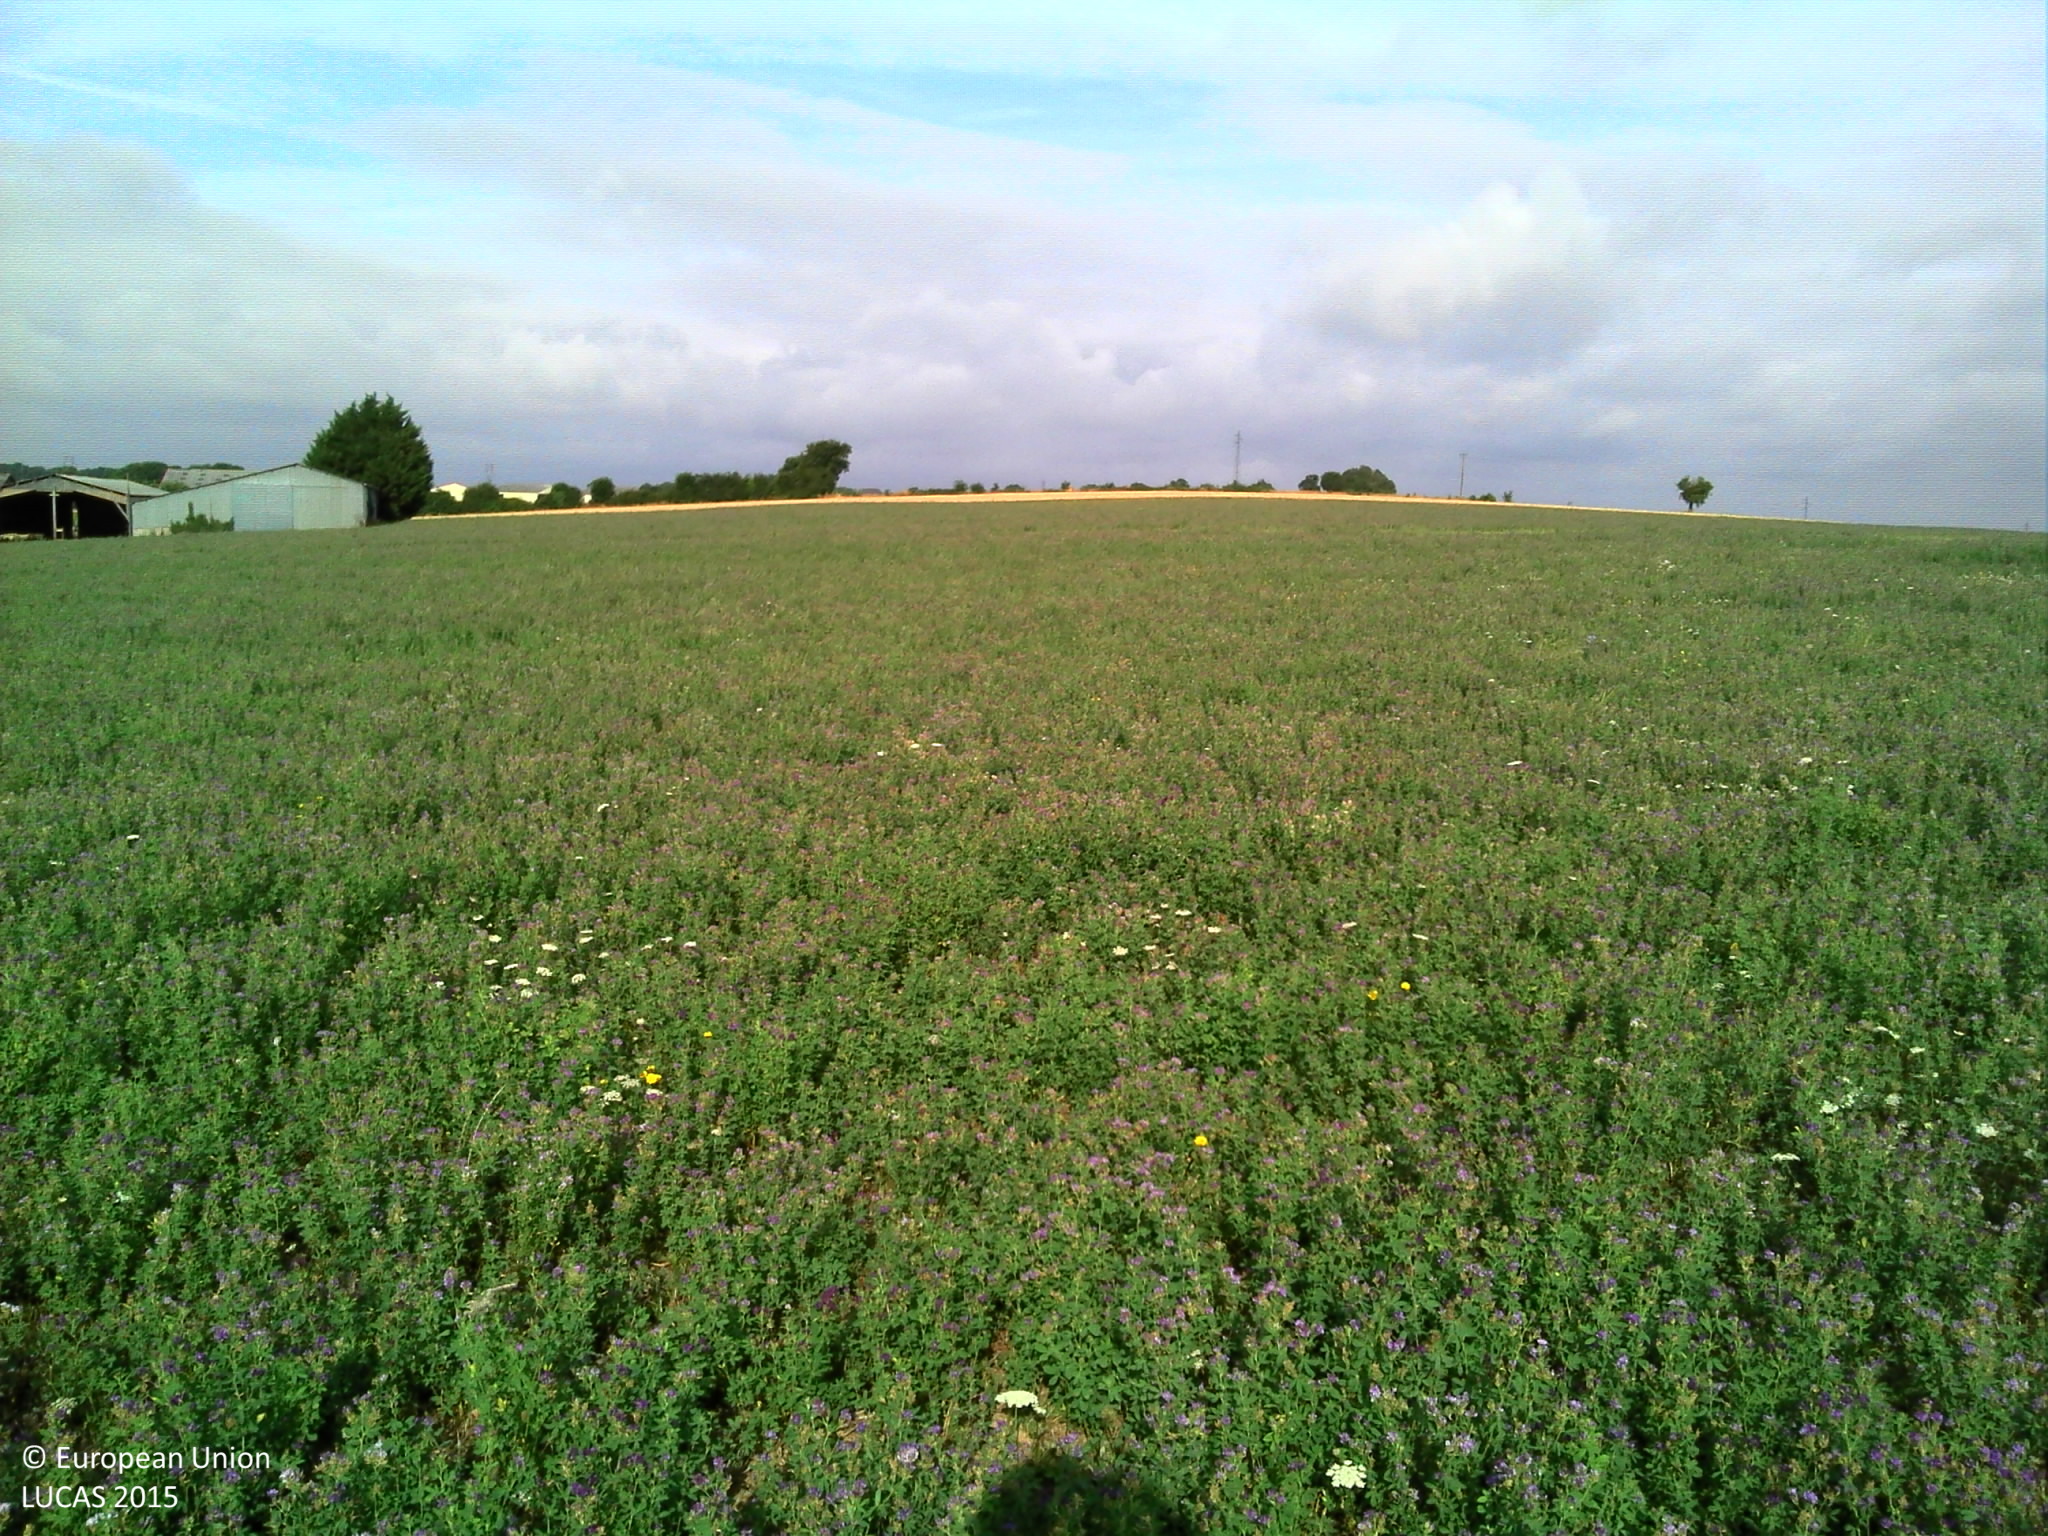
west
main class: Cropland
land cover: Lucerne
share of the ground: > 75 %
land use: Agriculture (excluding fallow land and kitchen gardens)
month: August
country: FR
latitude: 47.7755
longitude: -1.3994
